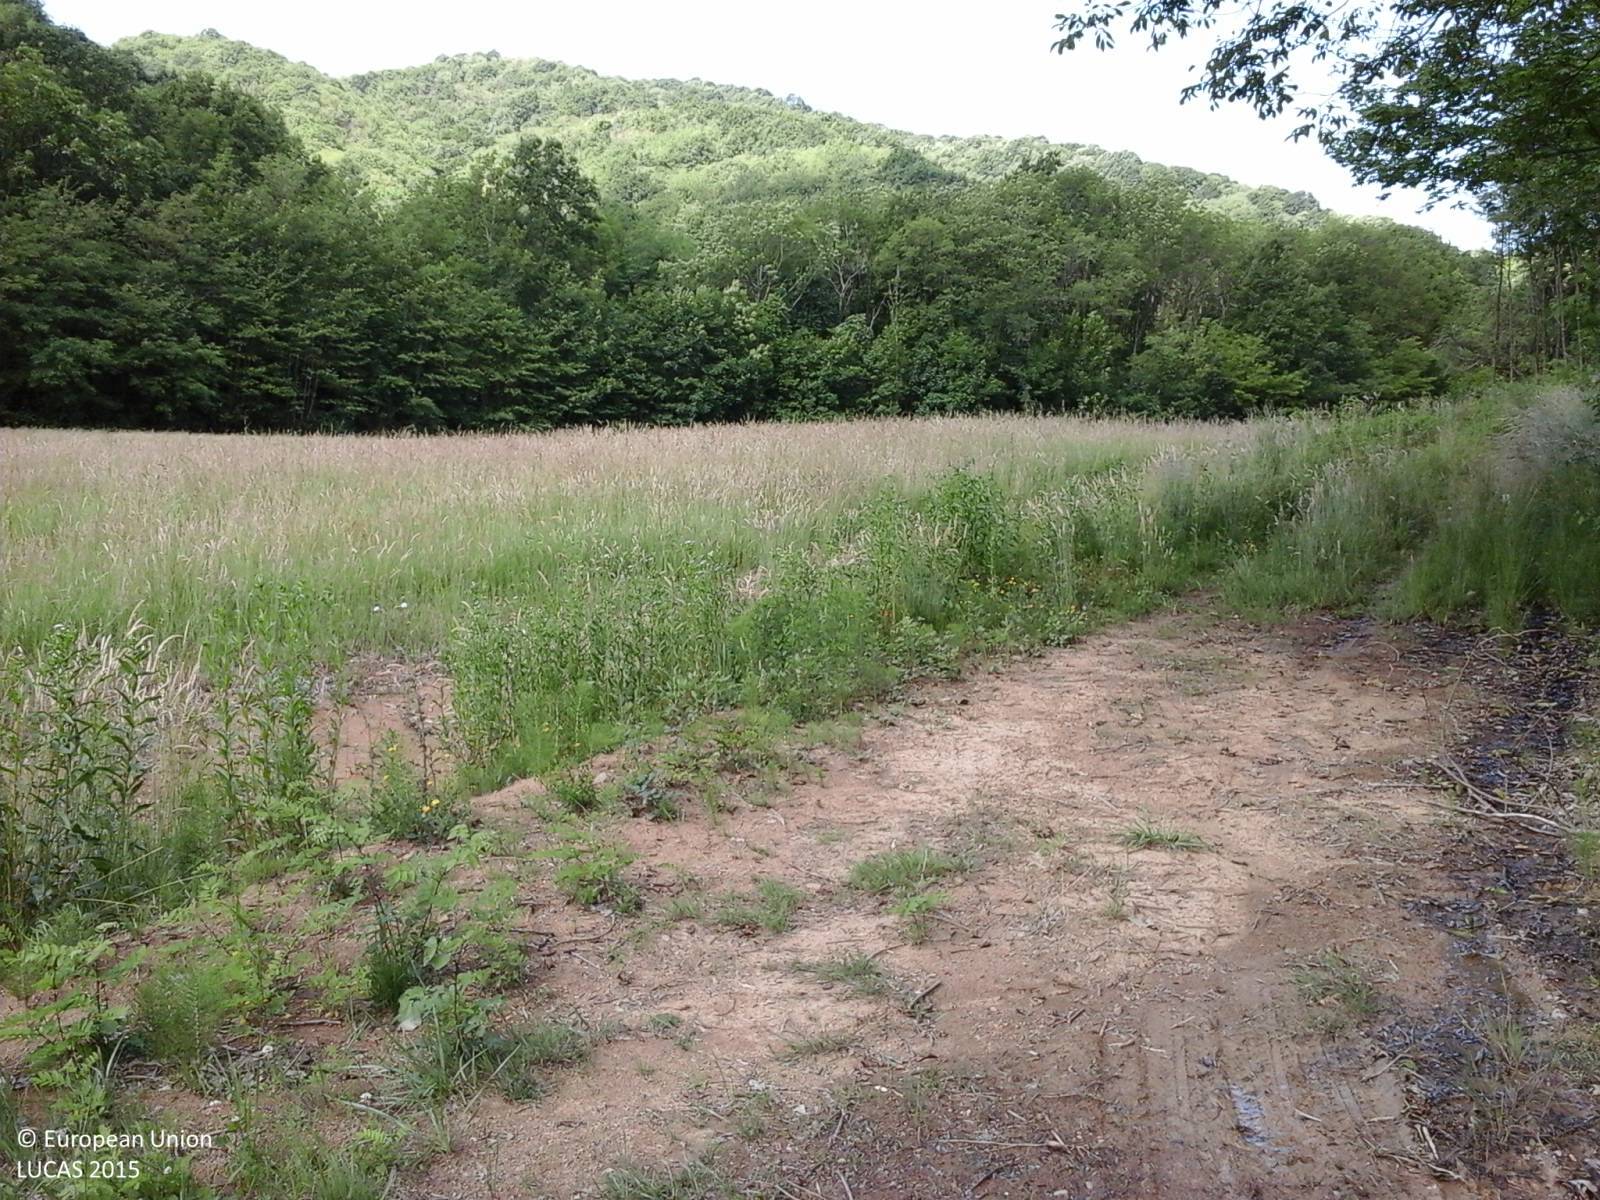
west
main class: Grassland
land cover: Spontaneously vegetated surfaces
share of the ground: < 10 %
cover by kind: unconsolidated bare surface 90 %, herbaceous plants 10 %
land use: Forestry
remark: Clear cut
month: June
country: IT
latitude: 46.1921
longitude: 13.3007
